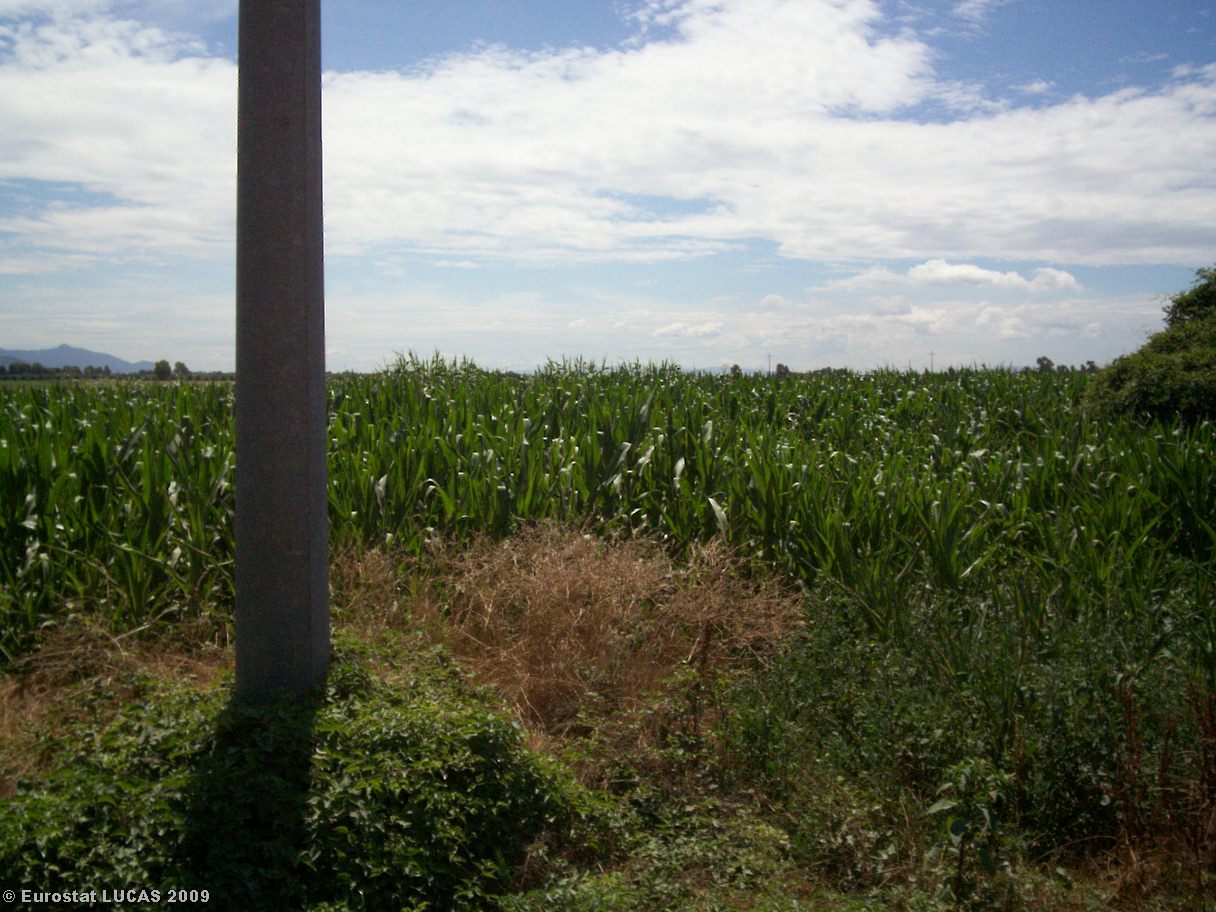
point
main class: Cropland
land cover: Maize
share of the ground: > 75 %
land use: Agriculture (excluding fallow land and kitchen gardens)
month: June
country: IT
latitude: 43.8088
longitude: 10.3347
